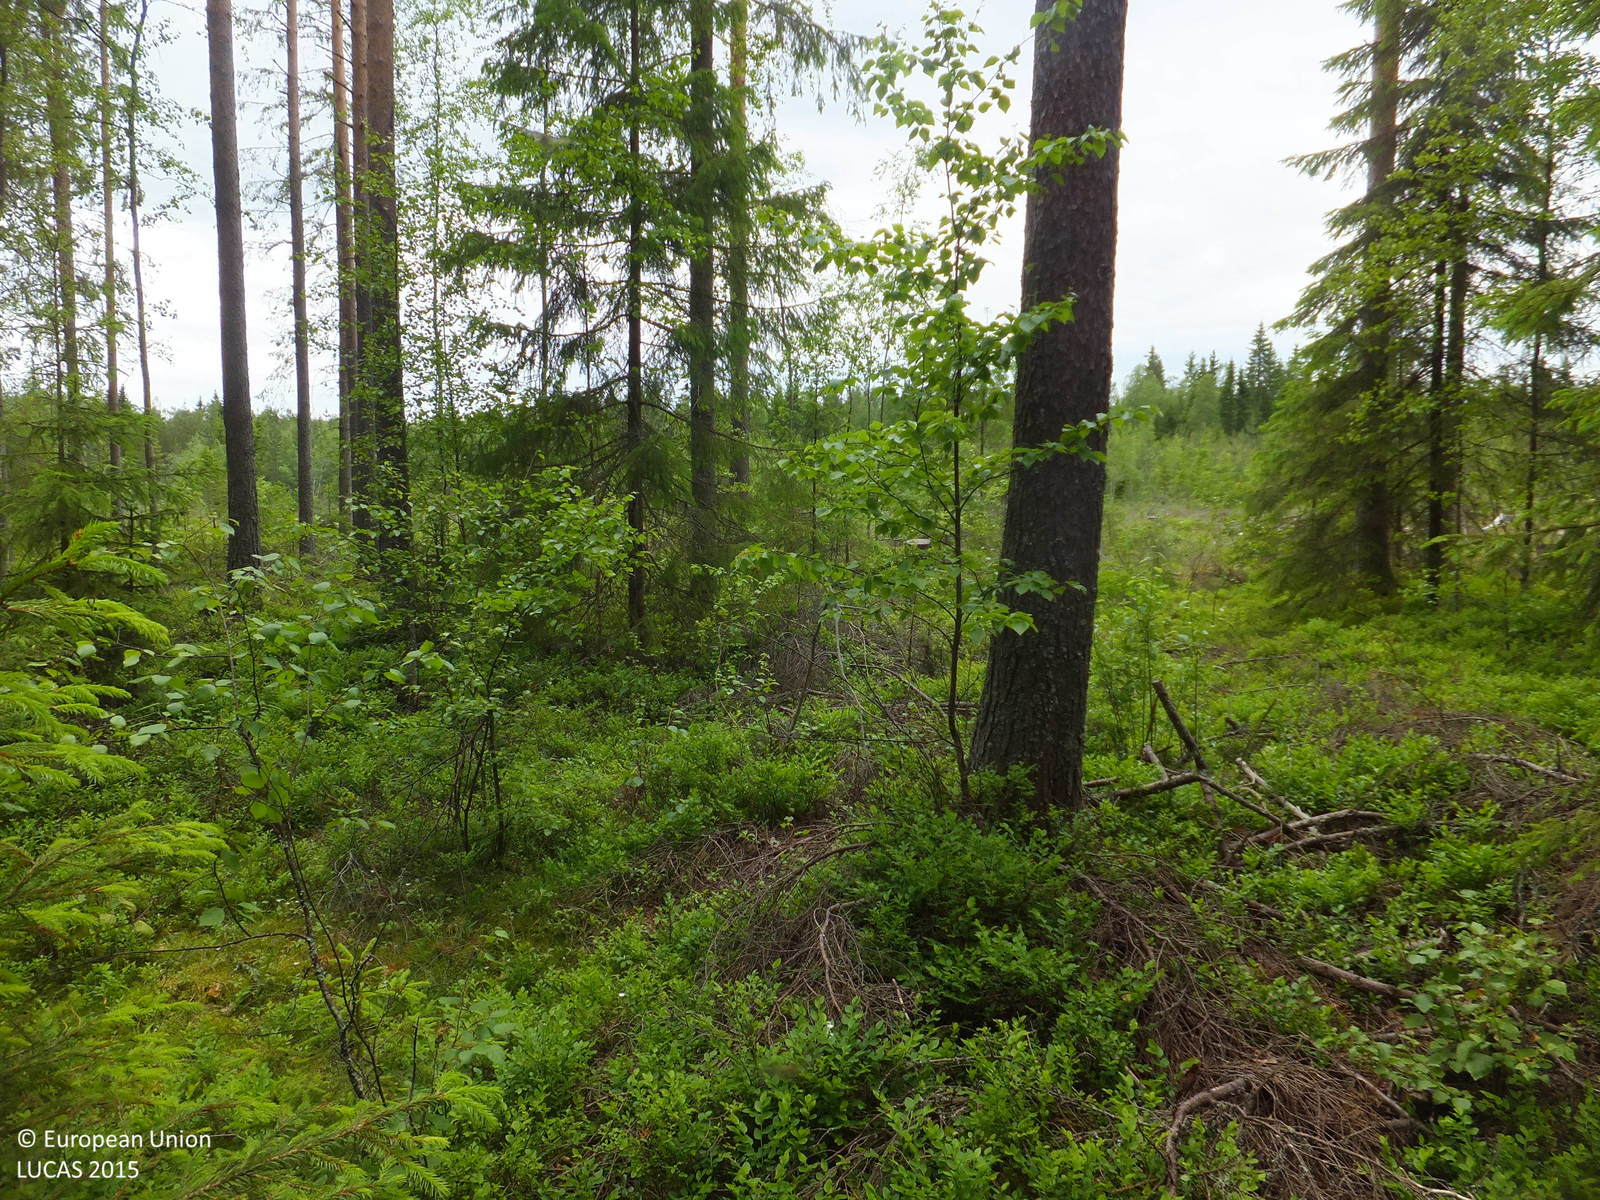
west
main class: Woodland
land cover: Other mixed woodland
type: boreal forest
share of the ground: > 75 %
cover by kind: coniferous forest trees 55 %, broadleaved forest trees 20 %, shrubs 15 %, lichens and mosses 10 %
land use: Forestry
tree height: > 5 m
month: June
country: FI
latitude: 63.4877
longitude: 24.1080
